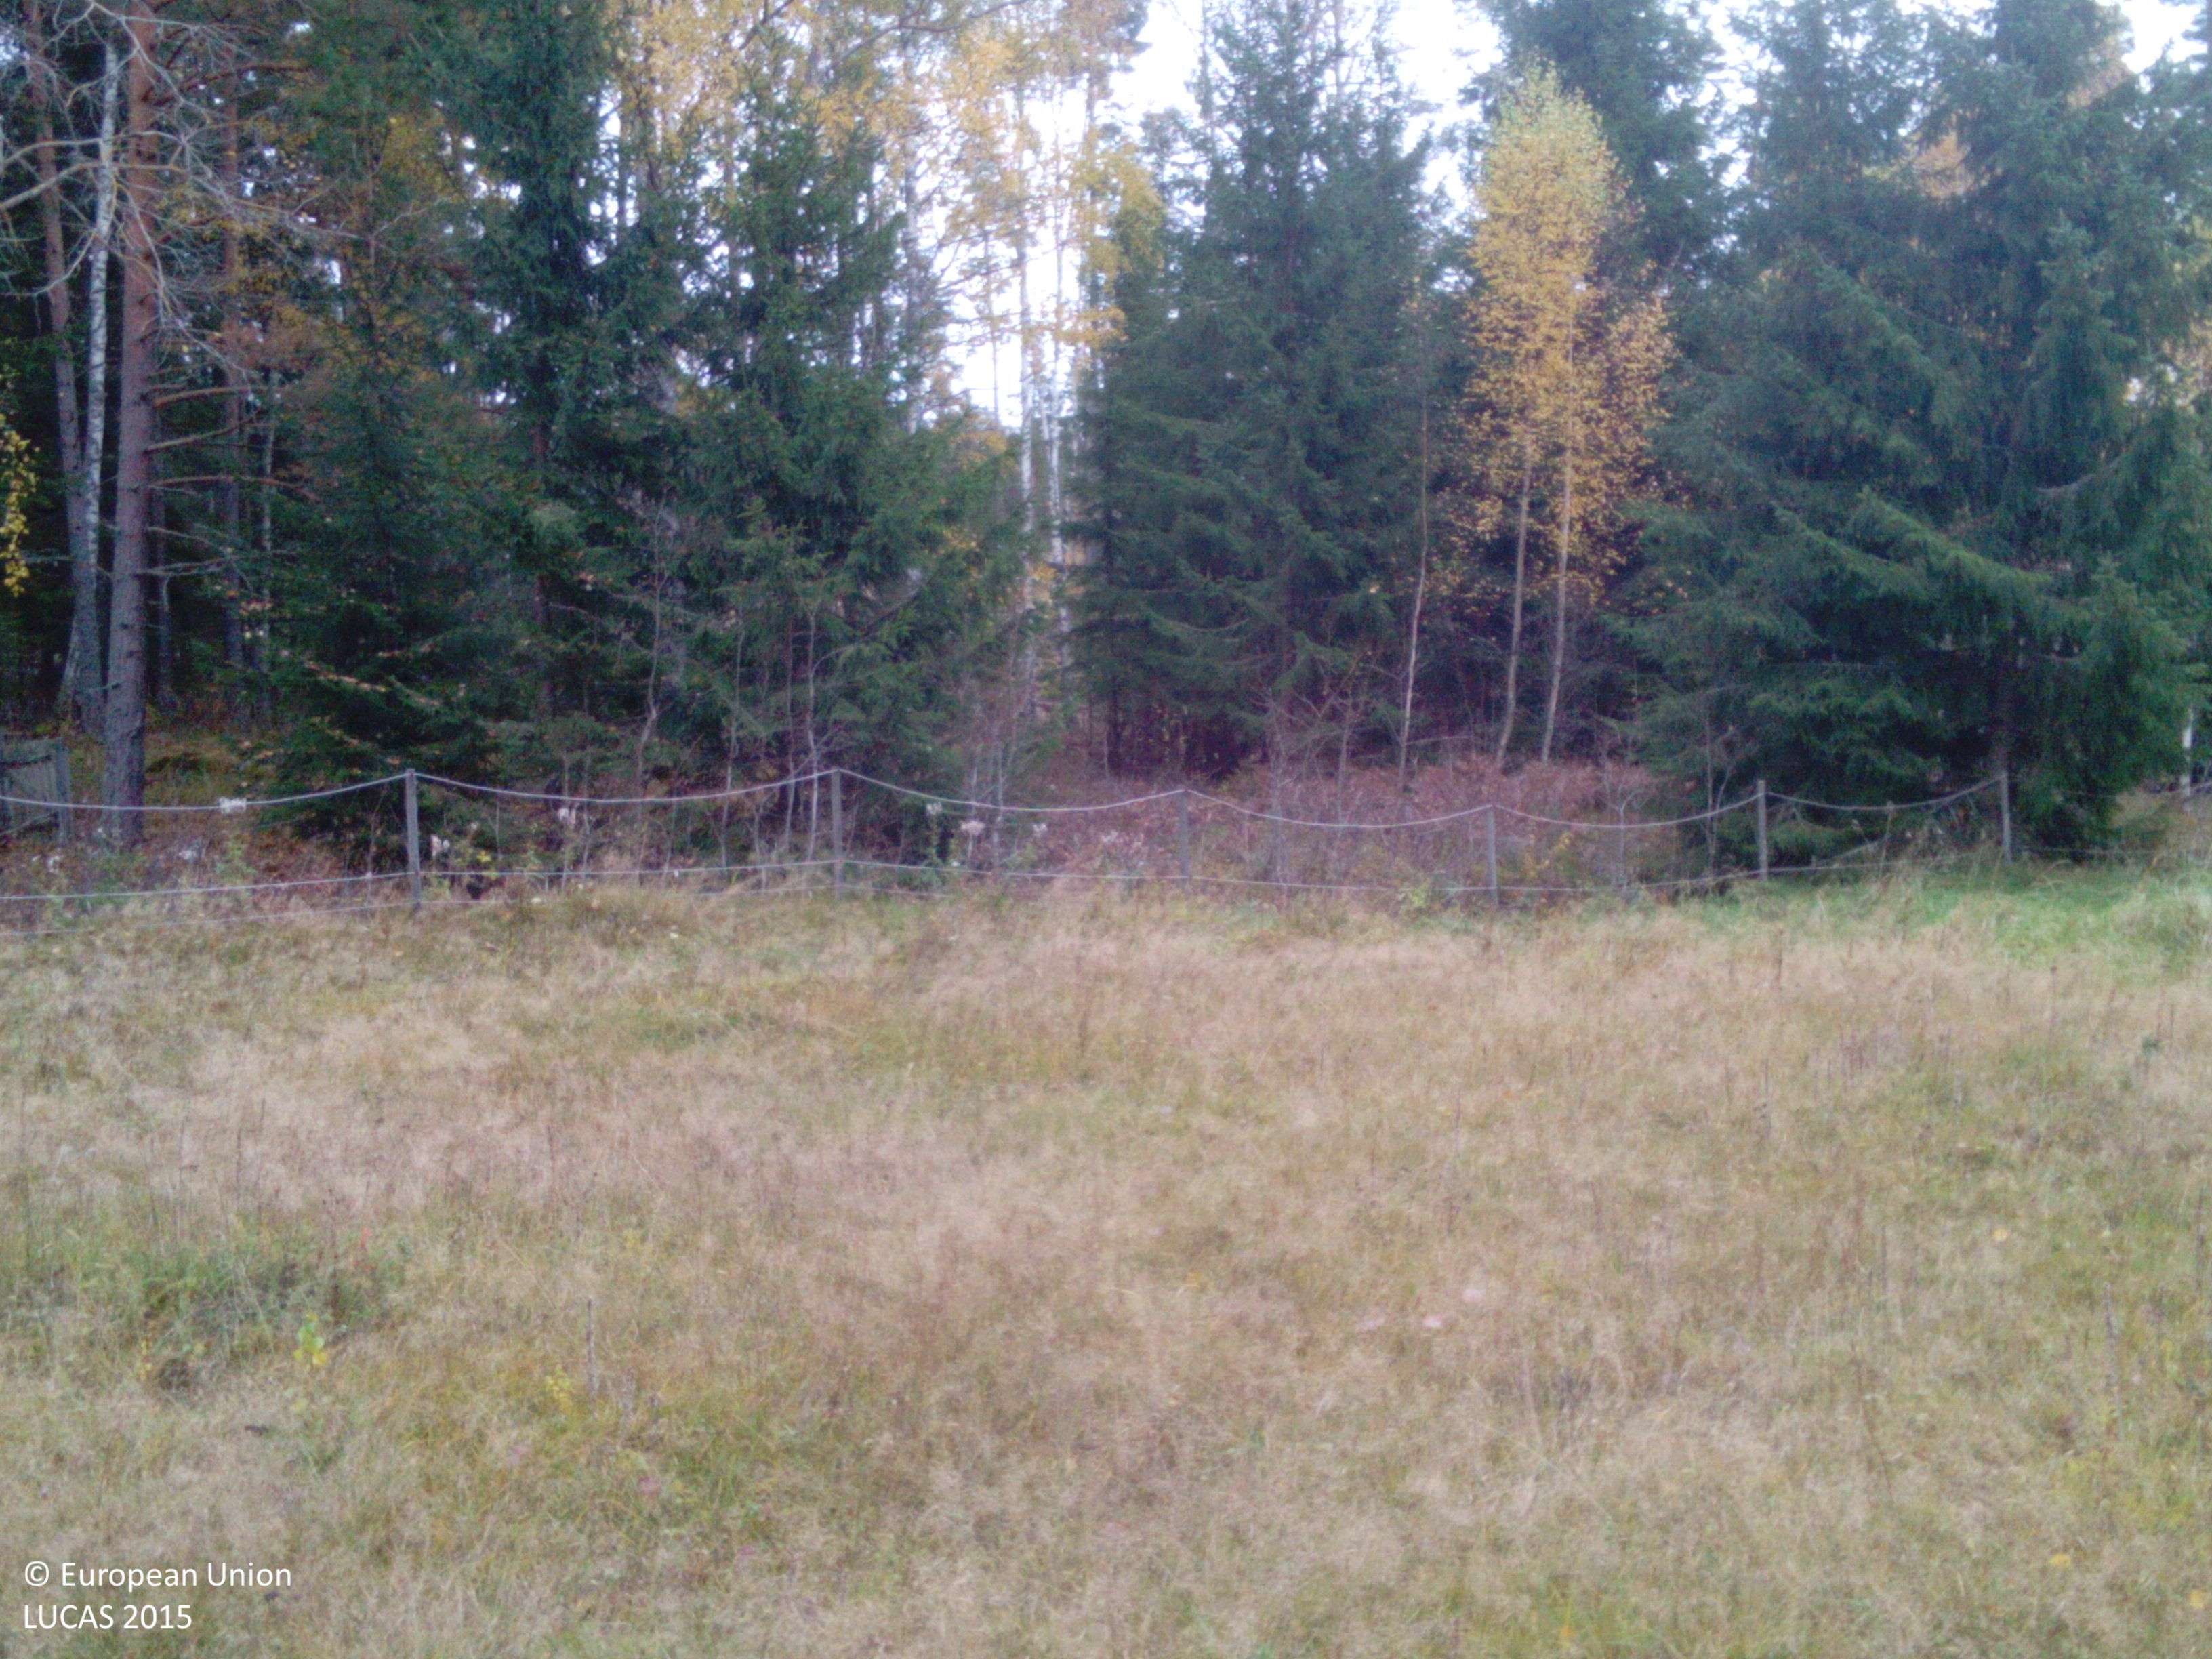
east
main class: Grassland
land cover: Grassland without tree/shrub cover
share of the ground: > 75 %
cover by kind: herbaceous plants 100 %
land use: Agriculture (excluding fallow land and kitchen gardens)
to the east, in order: Grassland without tree/shrub cover; Fences; Grass margins; Ditches and canals; Spruce dominated mixed woodland; Fences; Spruce dominated mixed woodland; Spruce dominated coniferous woodland; Spruce dominated mixed woodland; Other coniferous woodland
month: October
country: SE
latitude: 59.2474
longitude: 16.2524
